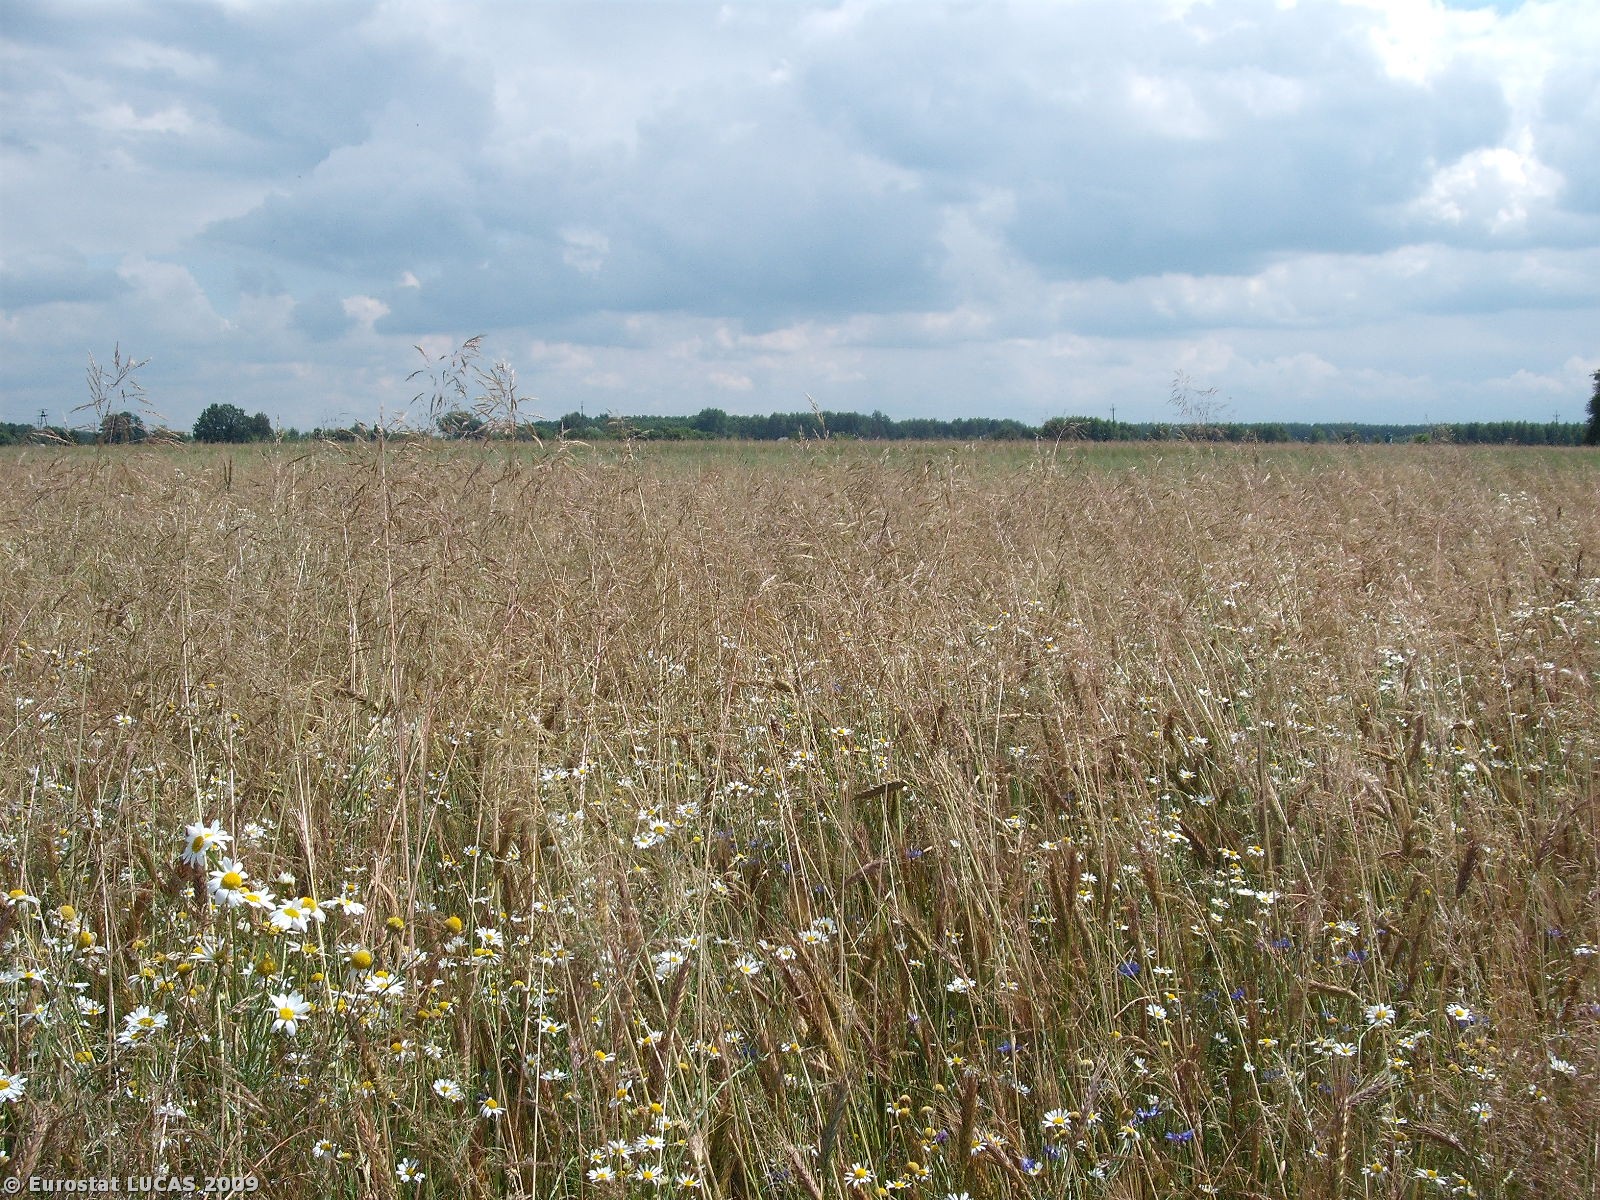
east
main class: Cropland
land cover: Triticale
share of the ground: > 75 %
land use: Agriculture (excluding fallow land and kitchen gardens)
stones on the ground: 10 - 25 %
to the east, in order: Triticale; Oats; Triticale; Ditches and canals; Tracks; Paved roads, cycling and walking lanes; Grass margins; Ditches and canals; Triticale; Grass margins; Spontaneously vegetated surfaces; Triticale
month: July
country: PL
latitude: 51.4422
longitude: 21.0514
